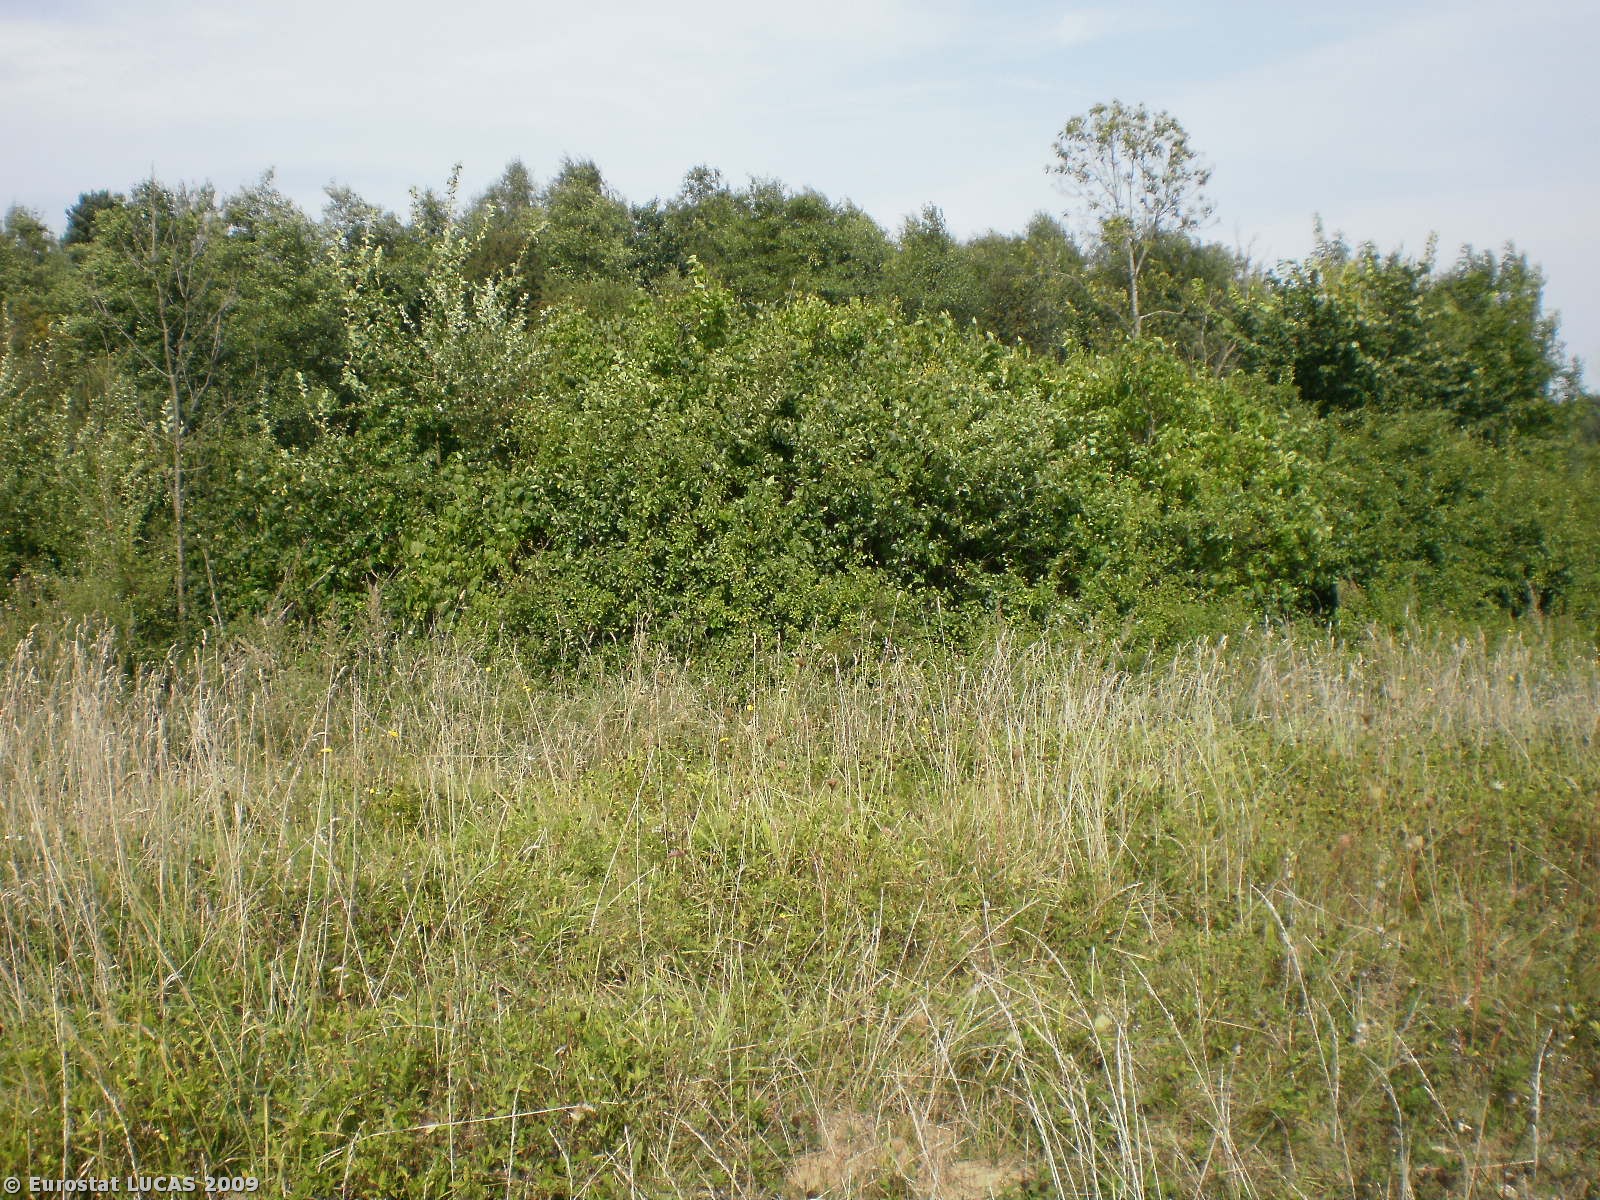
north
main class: Grassland
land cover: Grassland without tree/shrub cover
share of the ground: > 75 %
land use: Fallow land
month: September
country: PL
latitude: 53.8750
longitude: 21.4411
